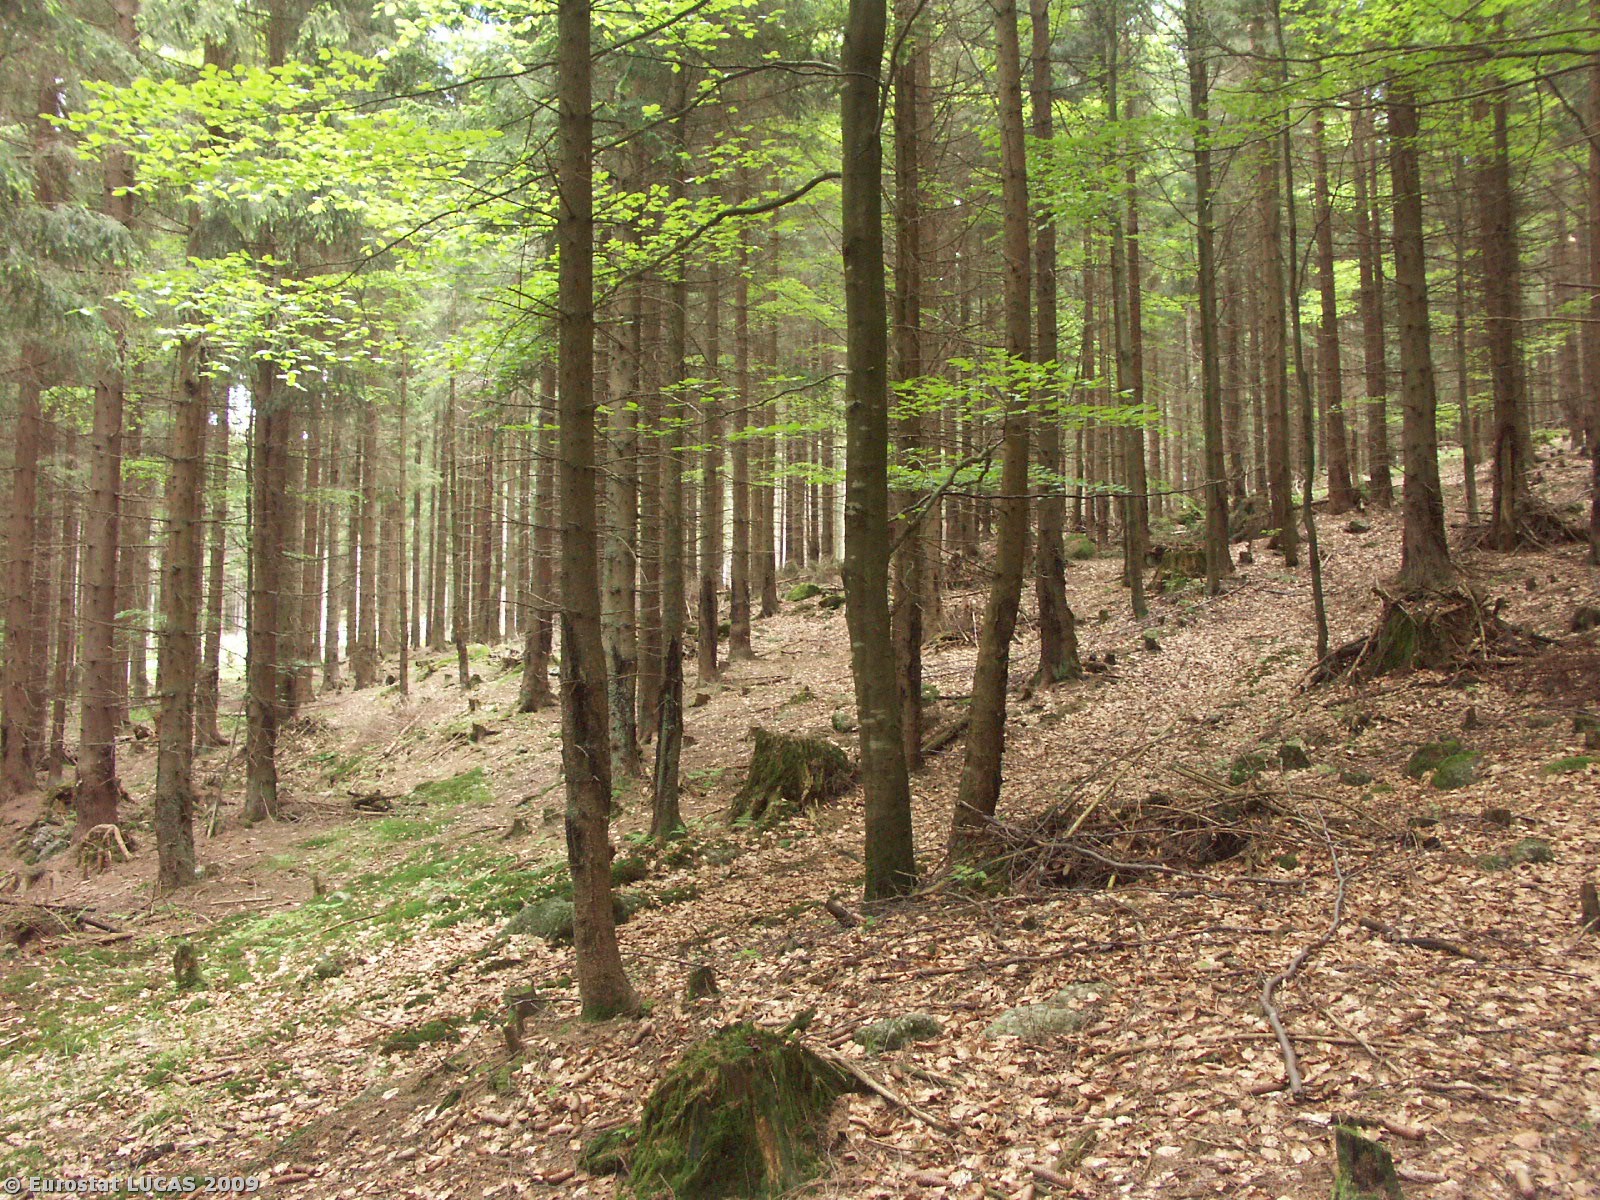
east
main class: Woodland
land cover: Mixed woodland
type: mountainous beech forest
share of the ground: > 75 %
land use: Forestry
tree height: > 5 m
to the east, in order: Mixed woodland; Tracks; Mixed woodland; Coniferous woodland; Tracks; Coniferous woodland; Fences; Coniferous woodland; Fences; Coniferous woodland
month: May
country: CZ
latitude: 48.6120
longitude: 14.6534
